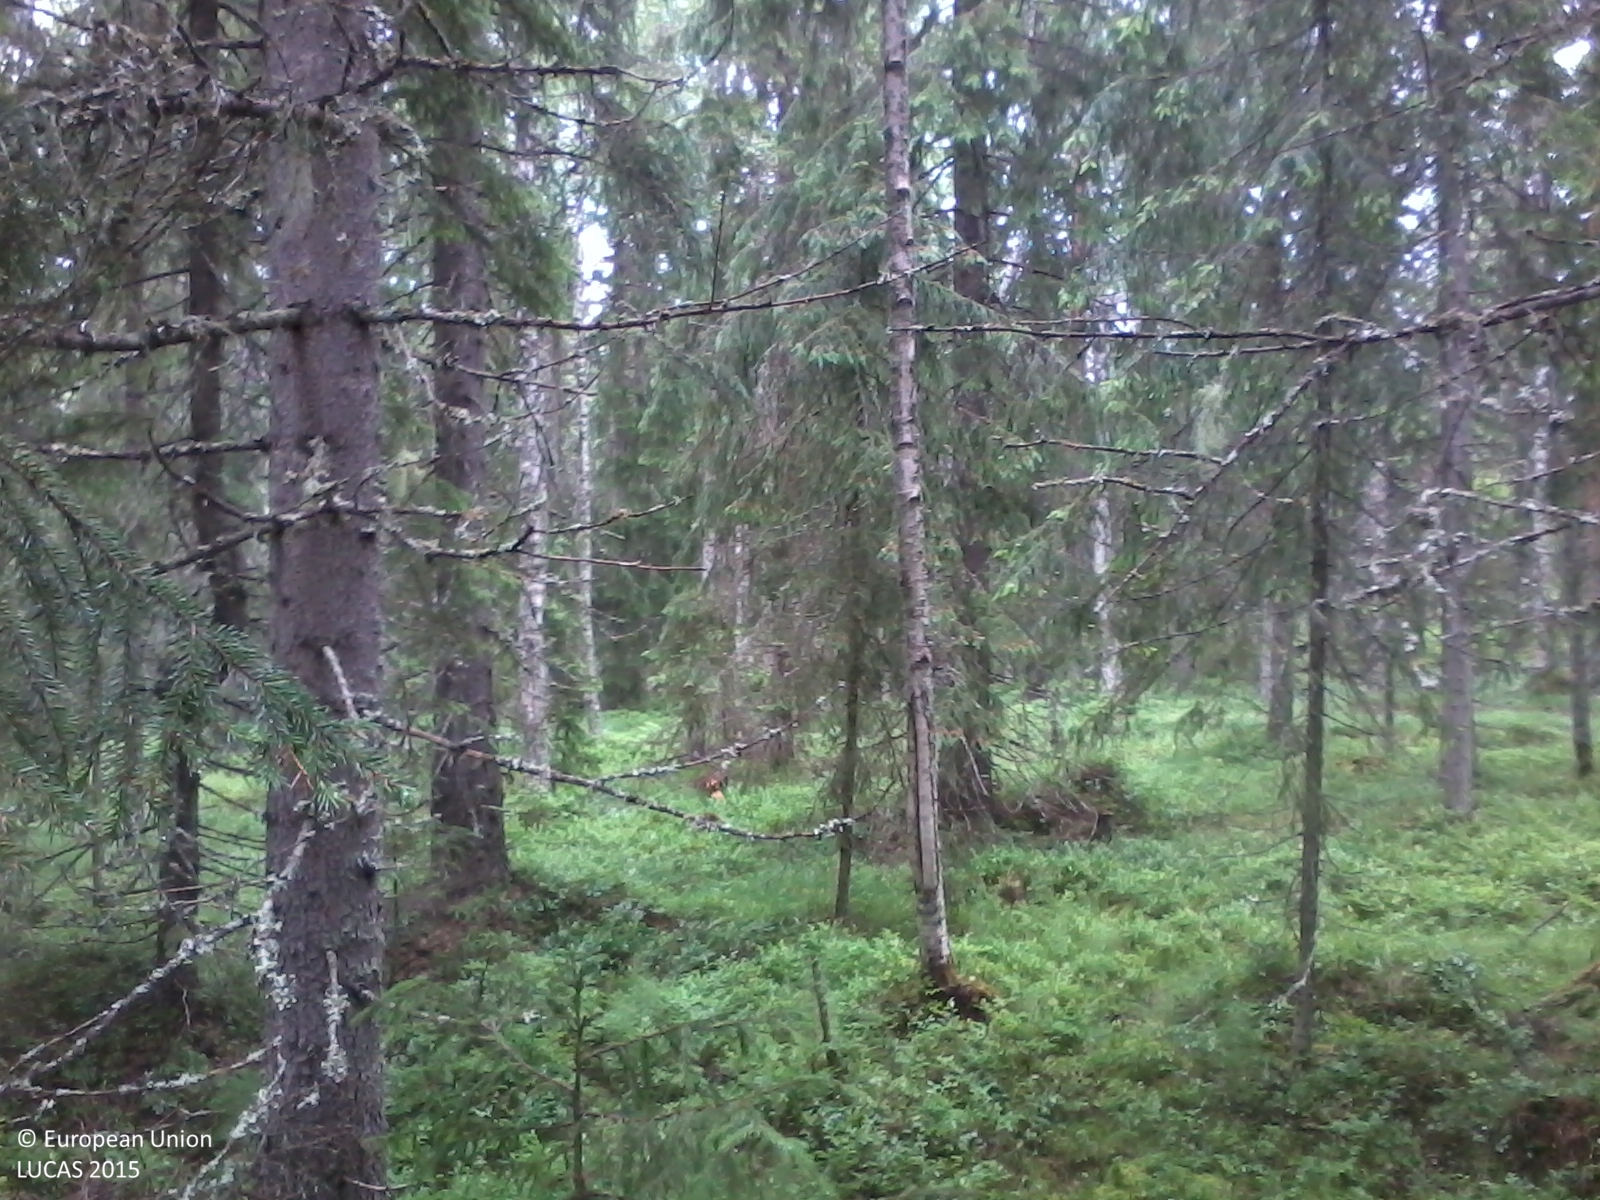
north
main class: Woodland
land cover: Spruce dominated mixed woodland
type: boreal forest
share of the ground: > 75 %
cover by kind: coniferous forest trees 60 %, broadleaved forest trees 20 %, shrubs 15 %, lichens and mosses 5 %
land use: Forestry
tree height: > 5 m
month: July
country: SE
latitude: 63.6316
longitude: 17.2985
